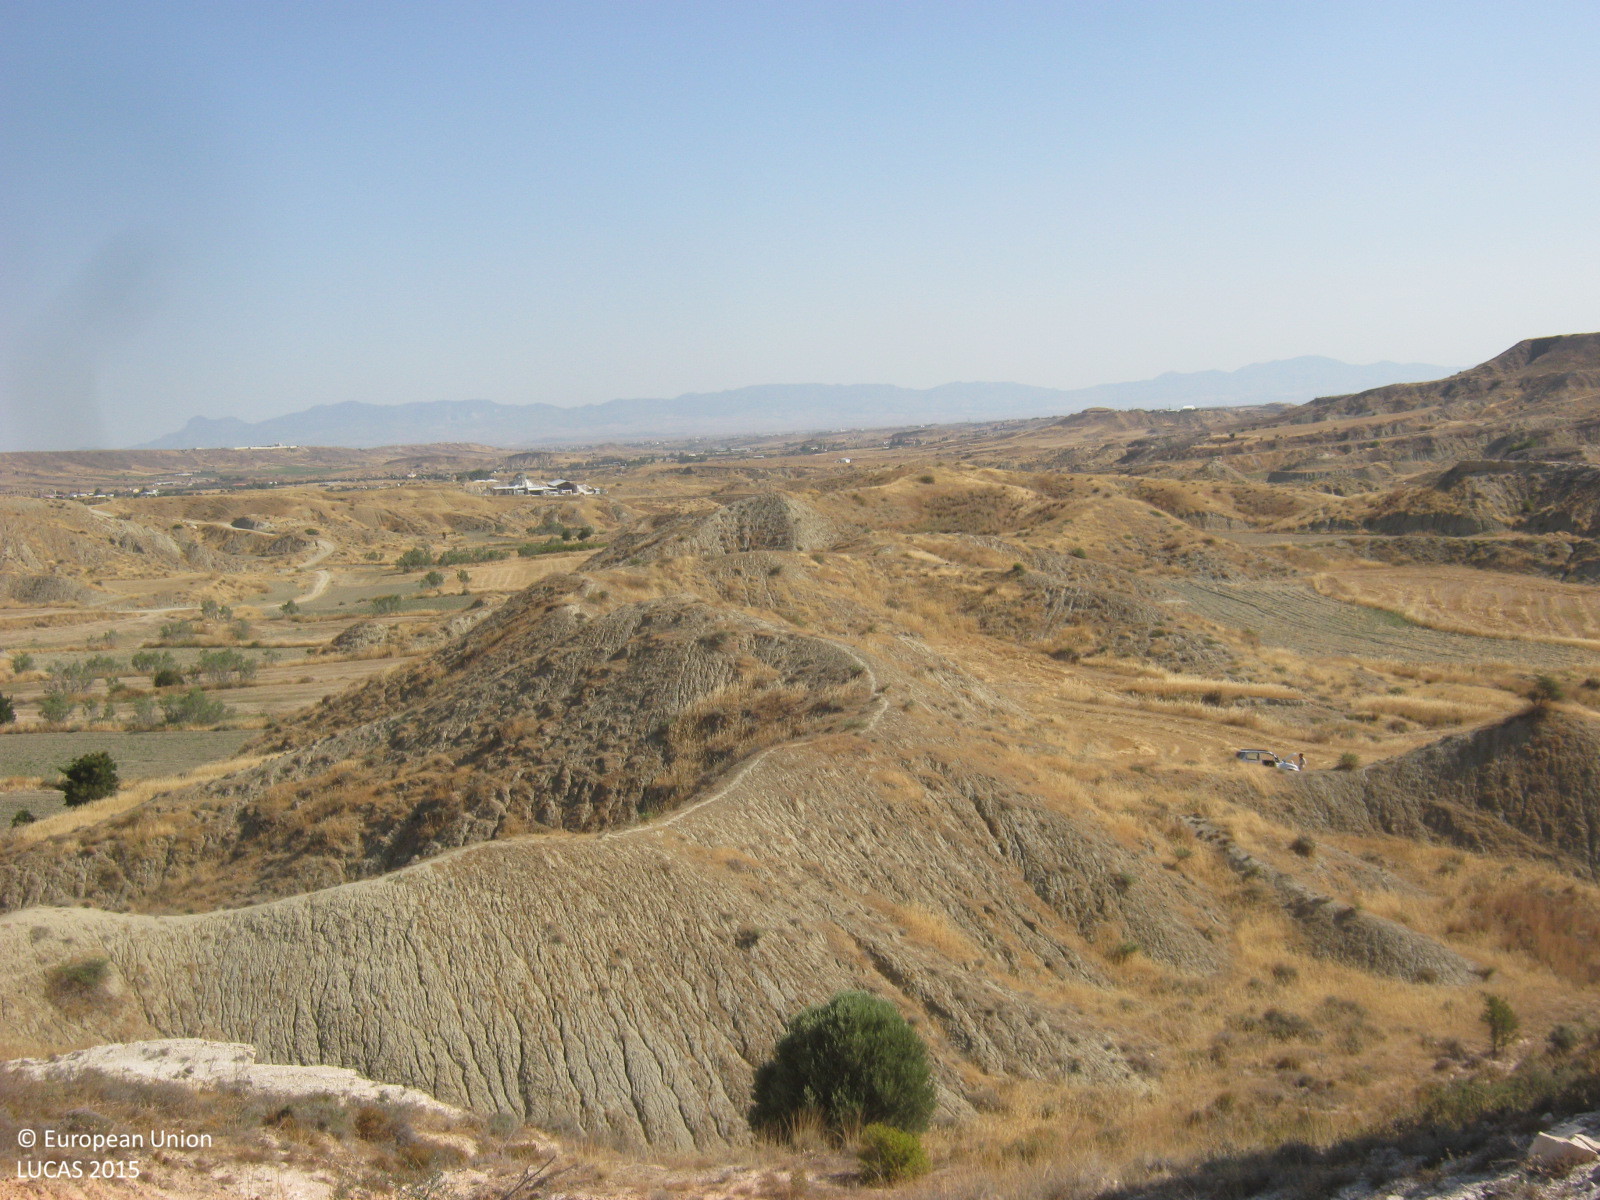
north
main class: Shrubland
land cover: Shrubland without tree cover
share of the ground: 10 - 25 %
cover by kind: unconsolidated bare surface 60 %, shrubs 20 %, herbaceous plants 20 %
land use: Semi-natural and natural areas not in use
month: June
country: CY
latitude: 35.0390
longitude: 33.2147
